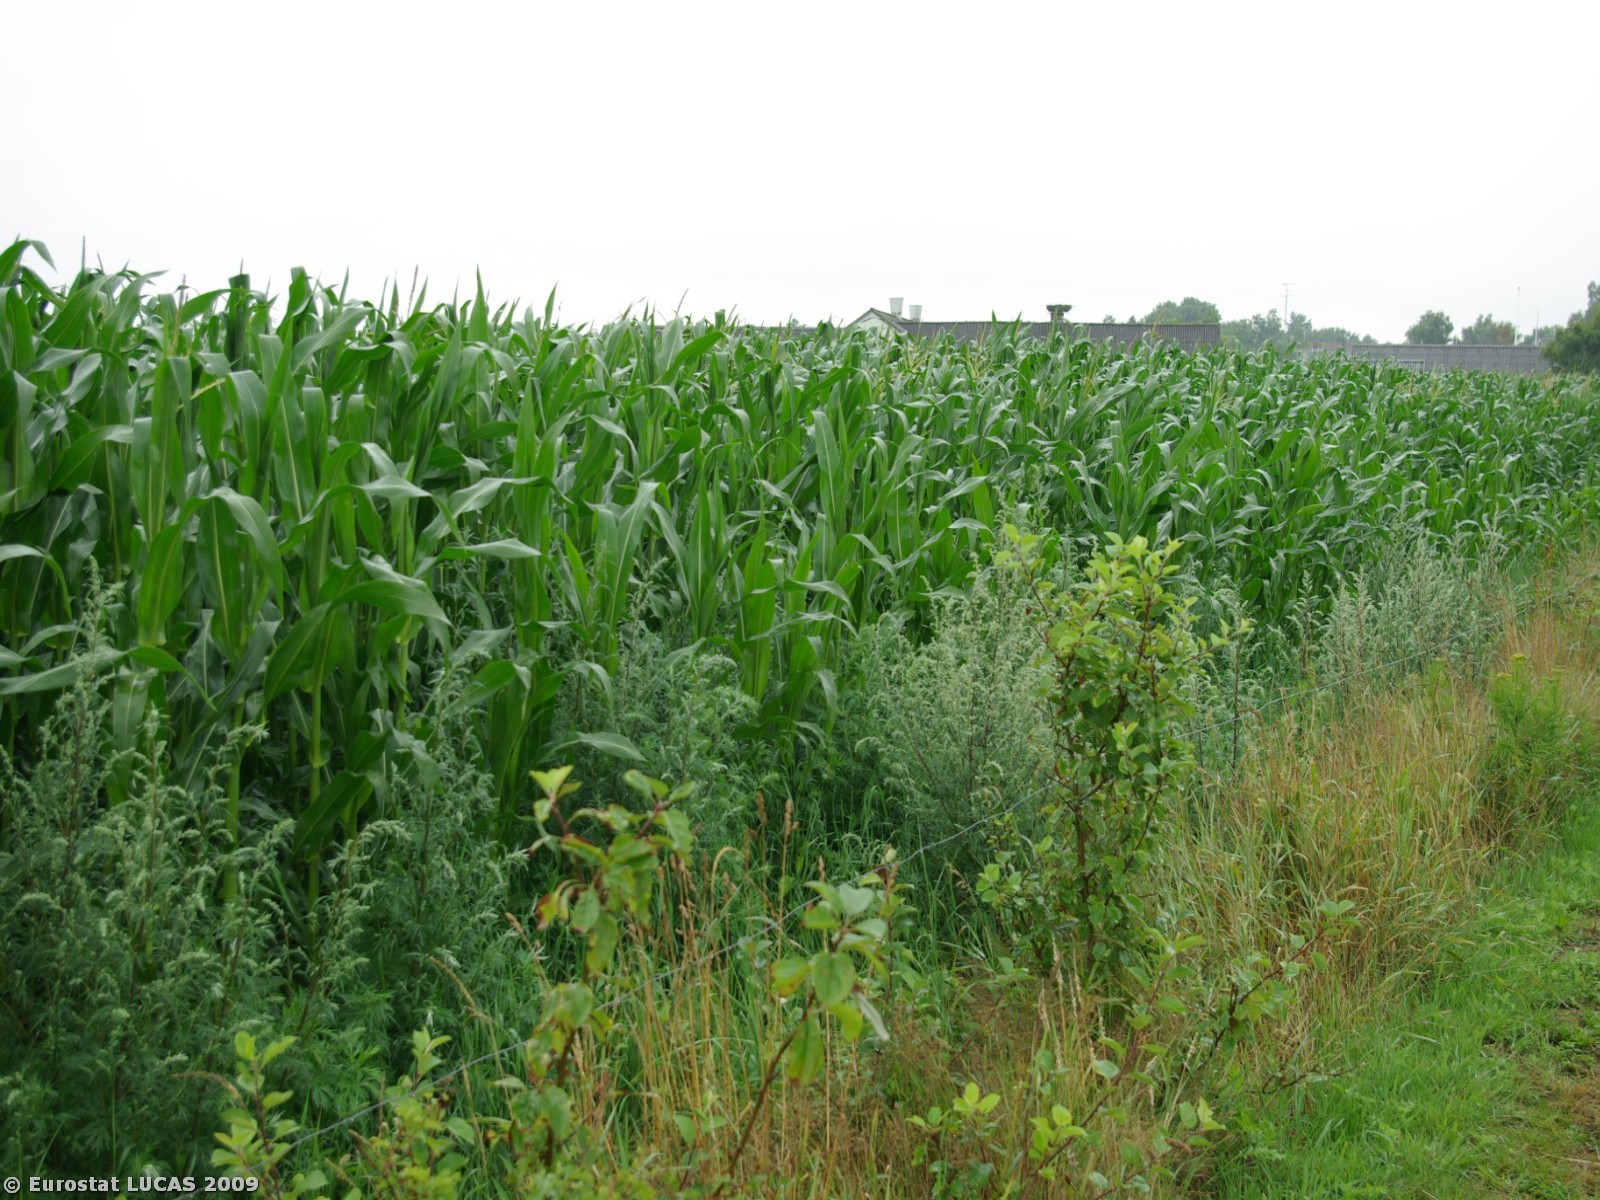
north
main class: Cropland
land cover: Maize
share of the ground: > 75 %
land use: Agriculture (excluding fallow land and kitchen gardens)
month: July
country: DK
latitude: 55.2476
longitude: 8.8212
